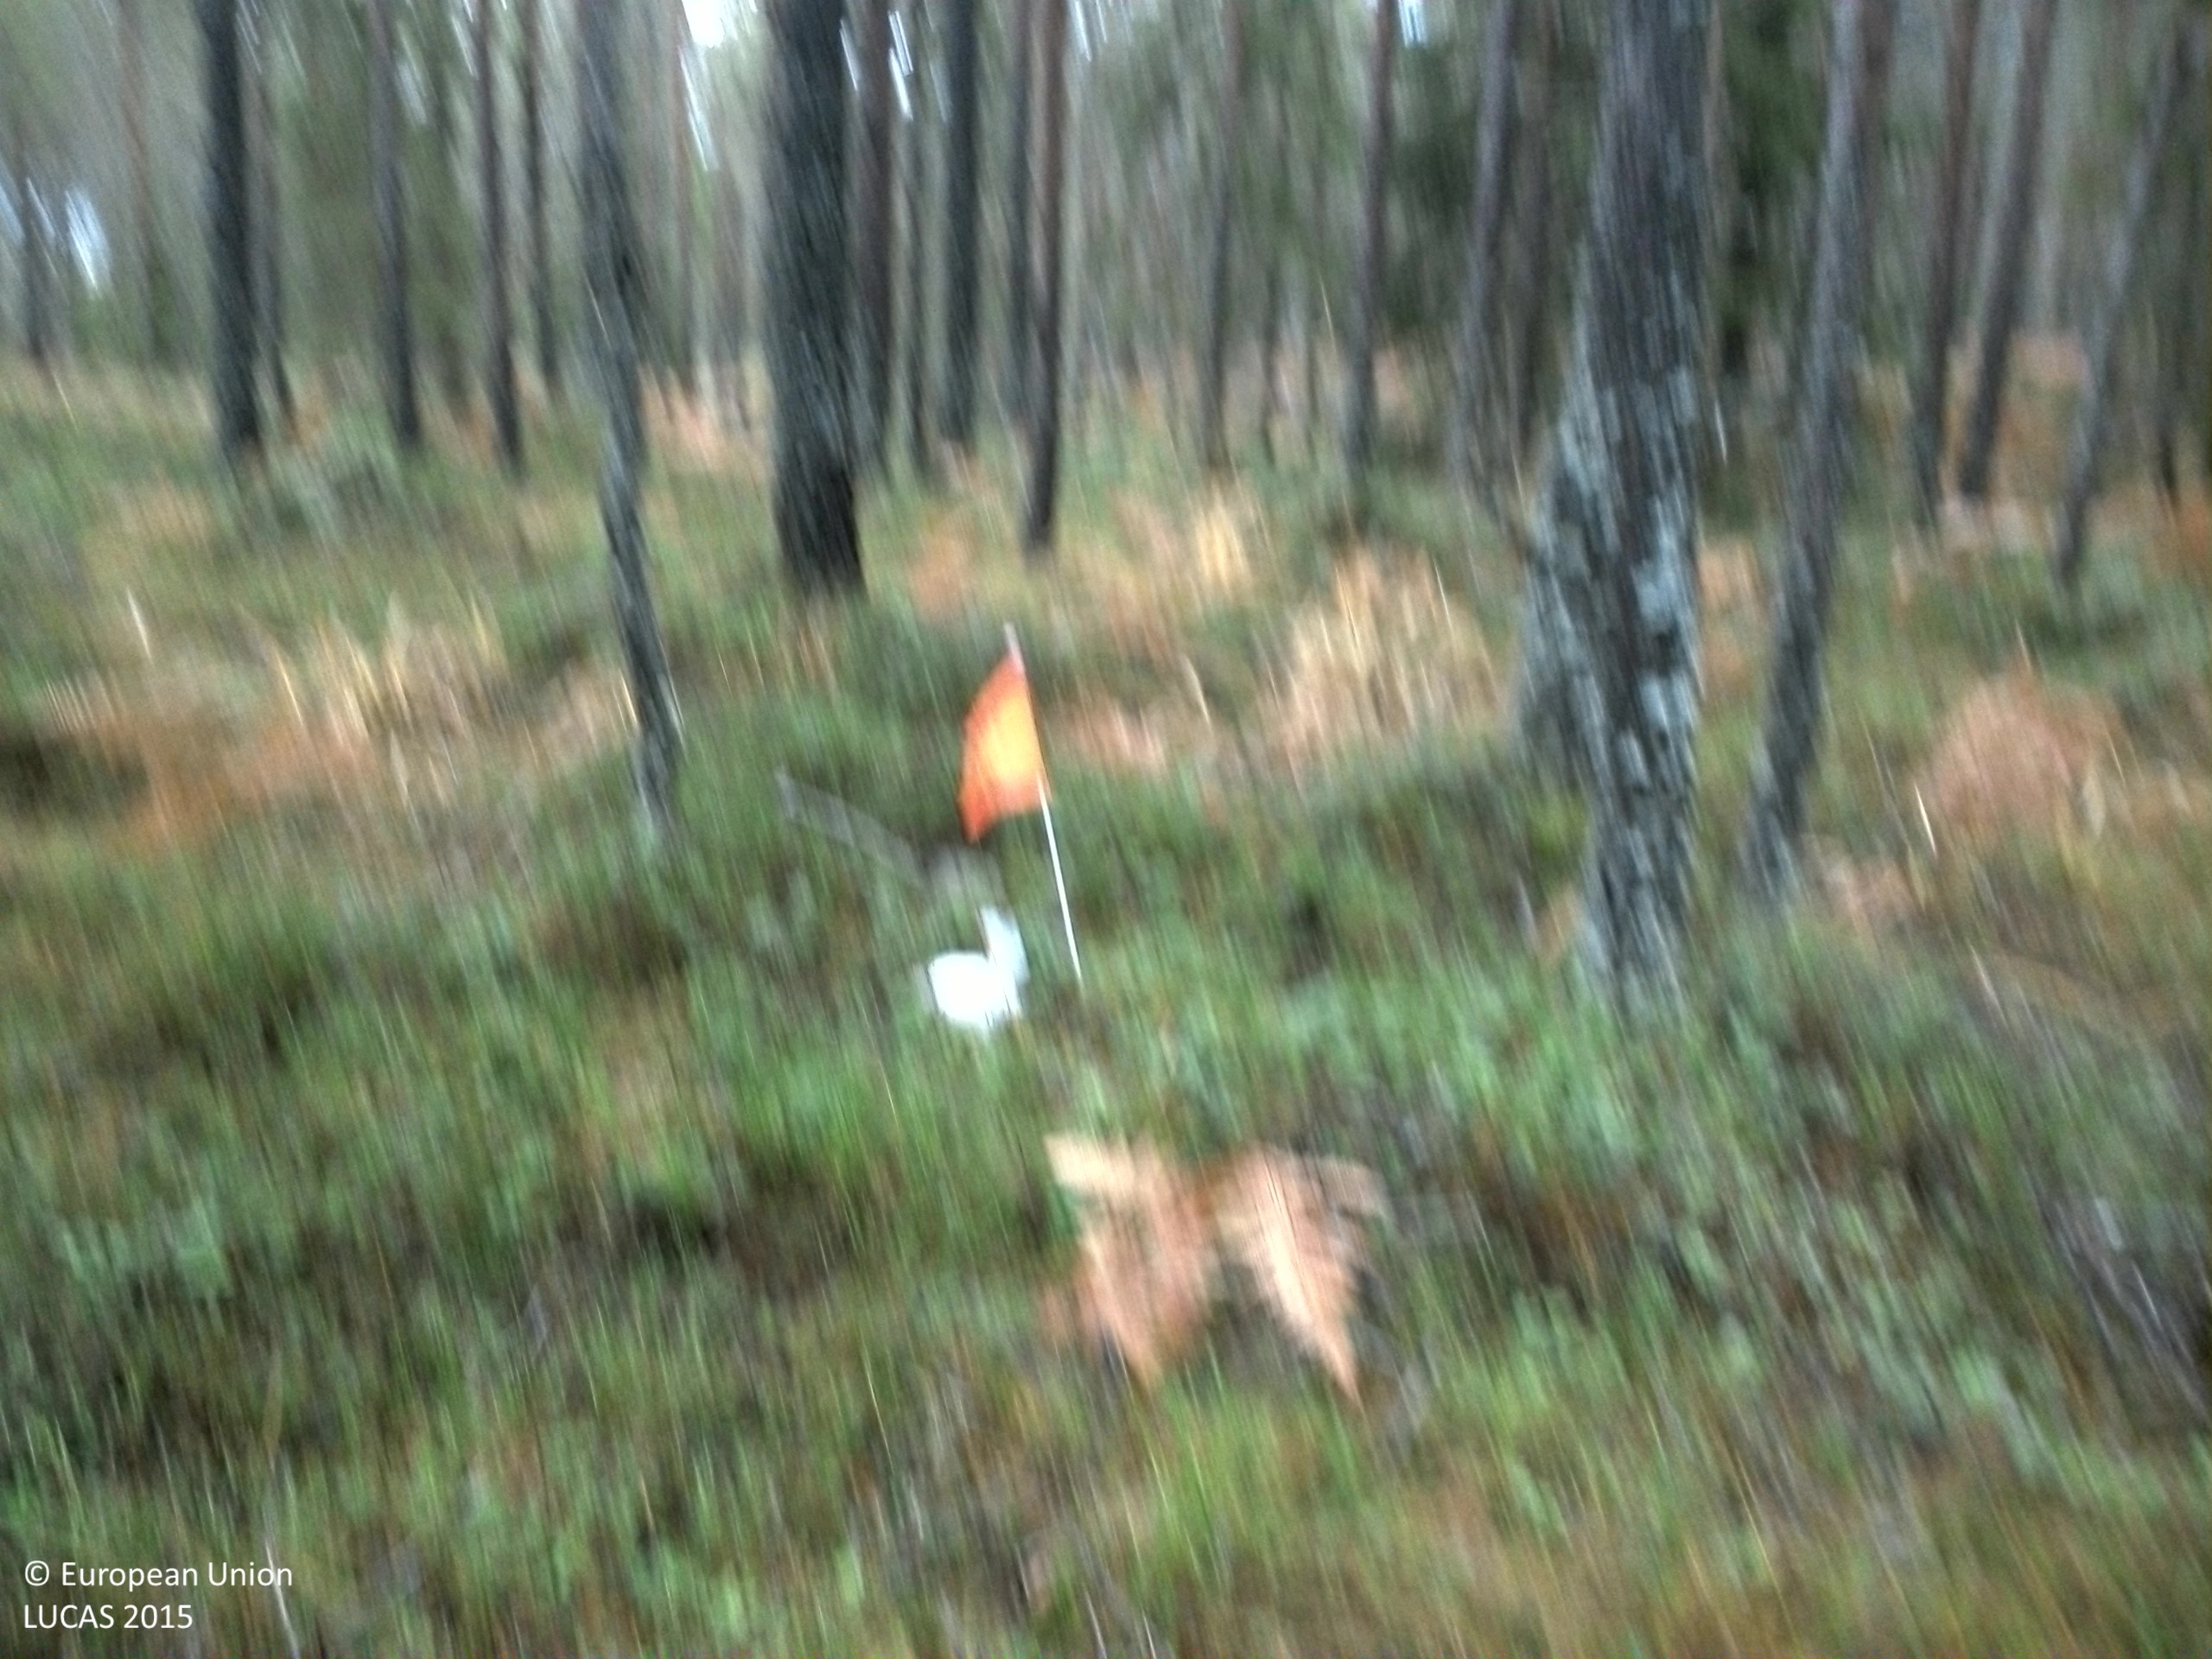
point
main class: Woodland
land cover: Pine dominated coniferous woodland
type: boreal forest
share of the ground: > 75 %
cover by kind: coniferous forest trees 75 %, shrubs 15 %, herbaceous plants 5 %, lichens and mosses 5 %
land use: Forestry
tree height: > 5 m
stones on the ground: 10 - 25 %
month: November
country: SE
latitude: 59.9545
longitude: 15.3075
